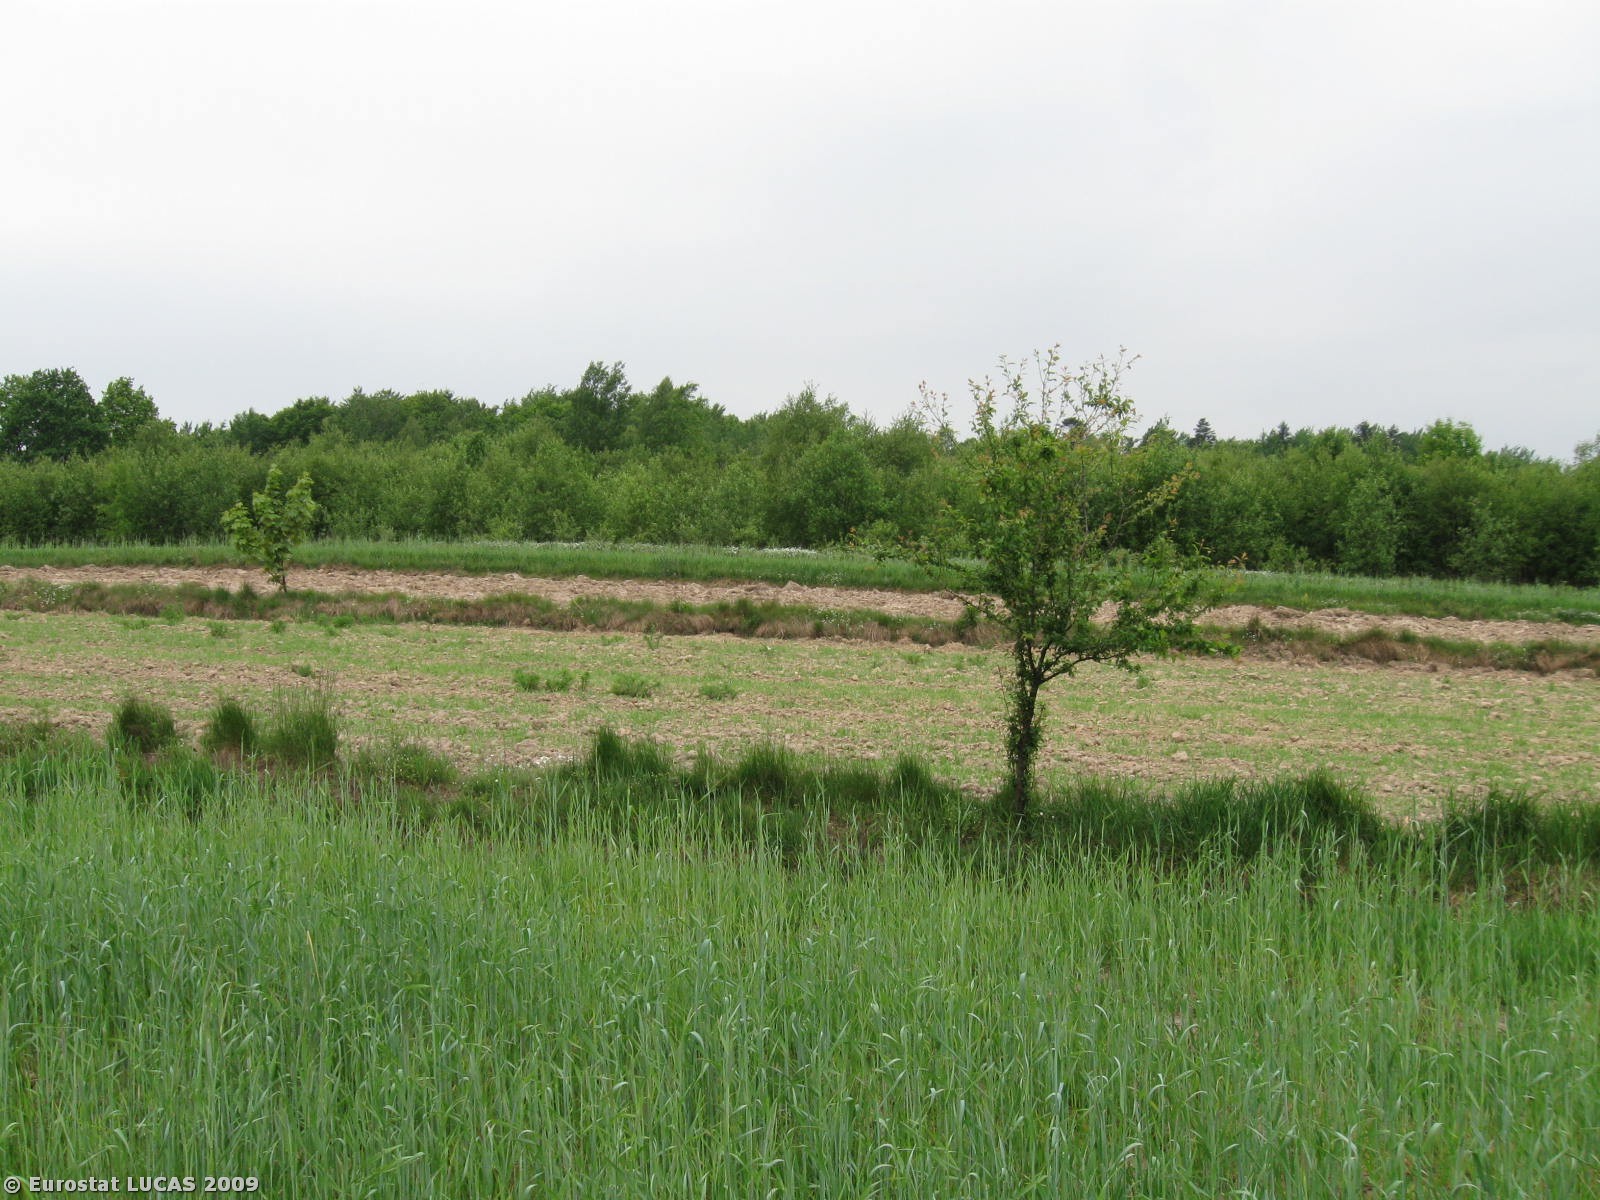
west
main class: Cropland
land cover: Rye
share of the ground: > 75 %
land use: Agriculture (excluding fallow land and kitchen gardens)
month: May
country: PL
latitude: 50.9697
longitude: 20.4762
